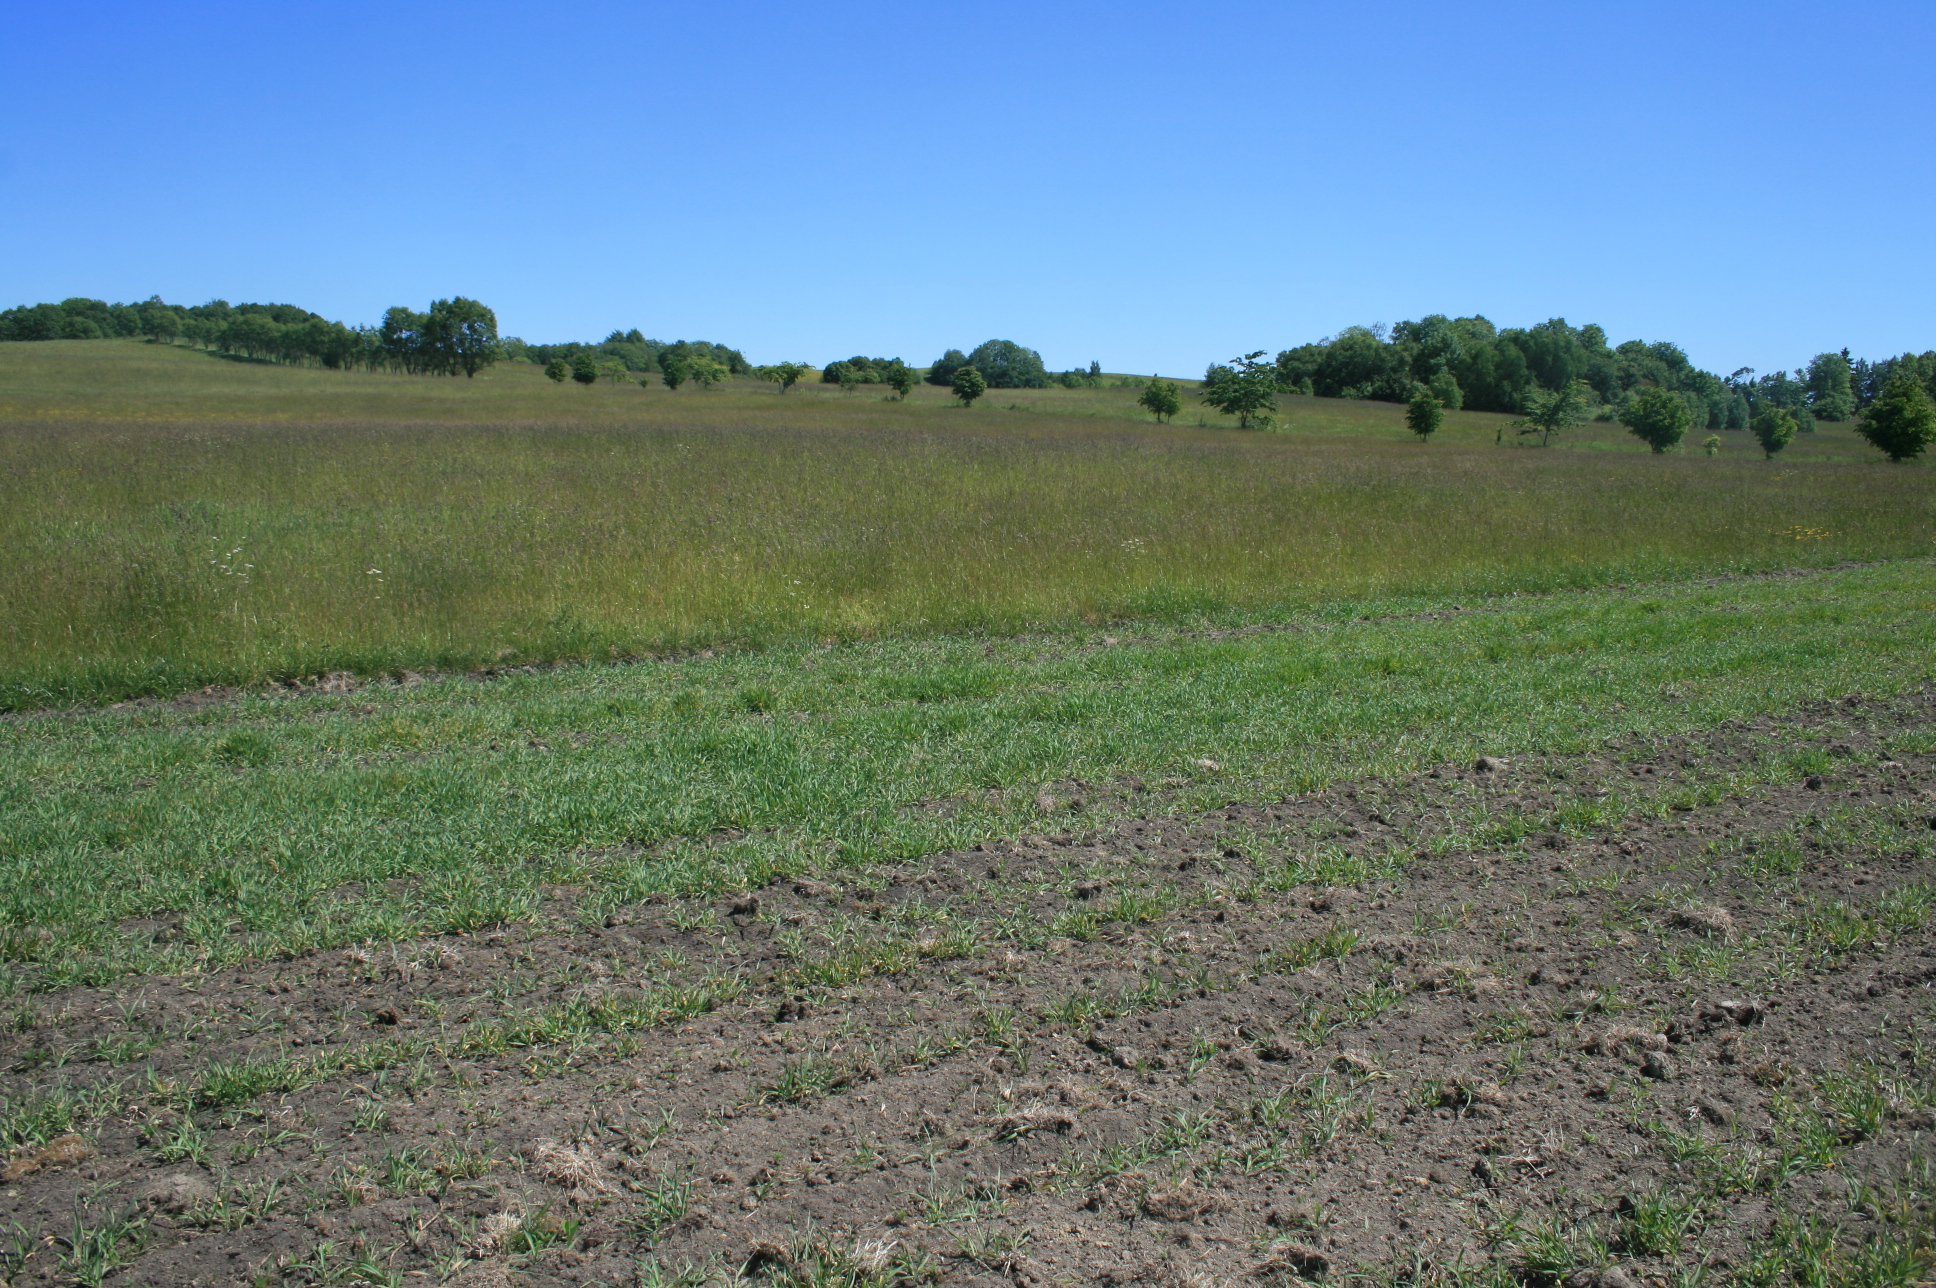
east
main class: Cropland
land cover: Barley
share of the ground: 25 - 50 %
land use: Agriculture (excluding fallow land and kitchen gardens)
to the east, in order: Barley; Grassland without tree/shrub cover; Lines of trees; Grass margins; Tracks; Grassland without tree/shrub cover
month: June
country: LT
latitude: 55.5325
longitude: 22.1761
